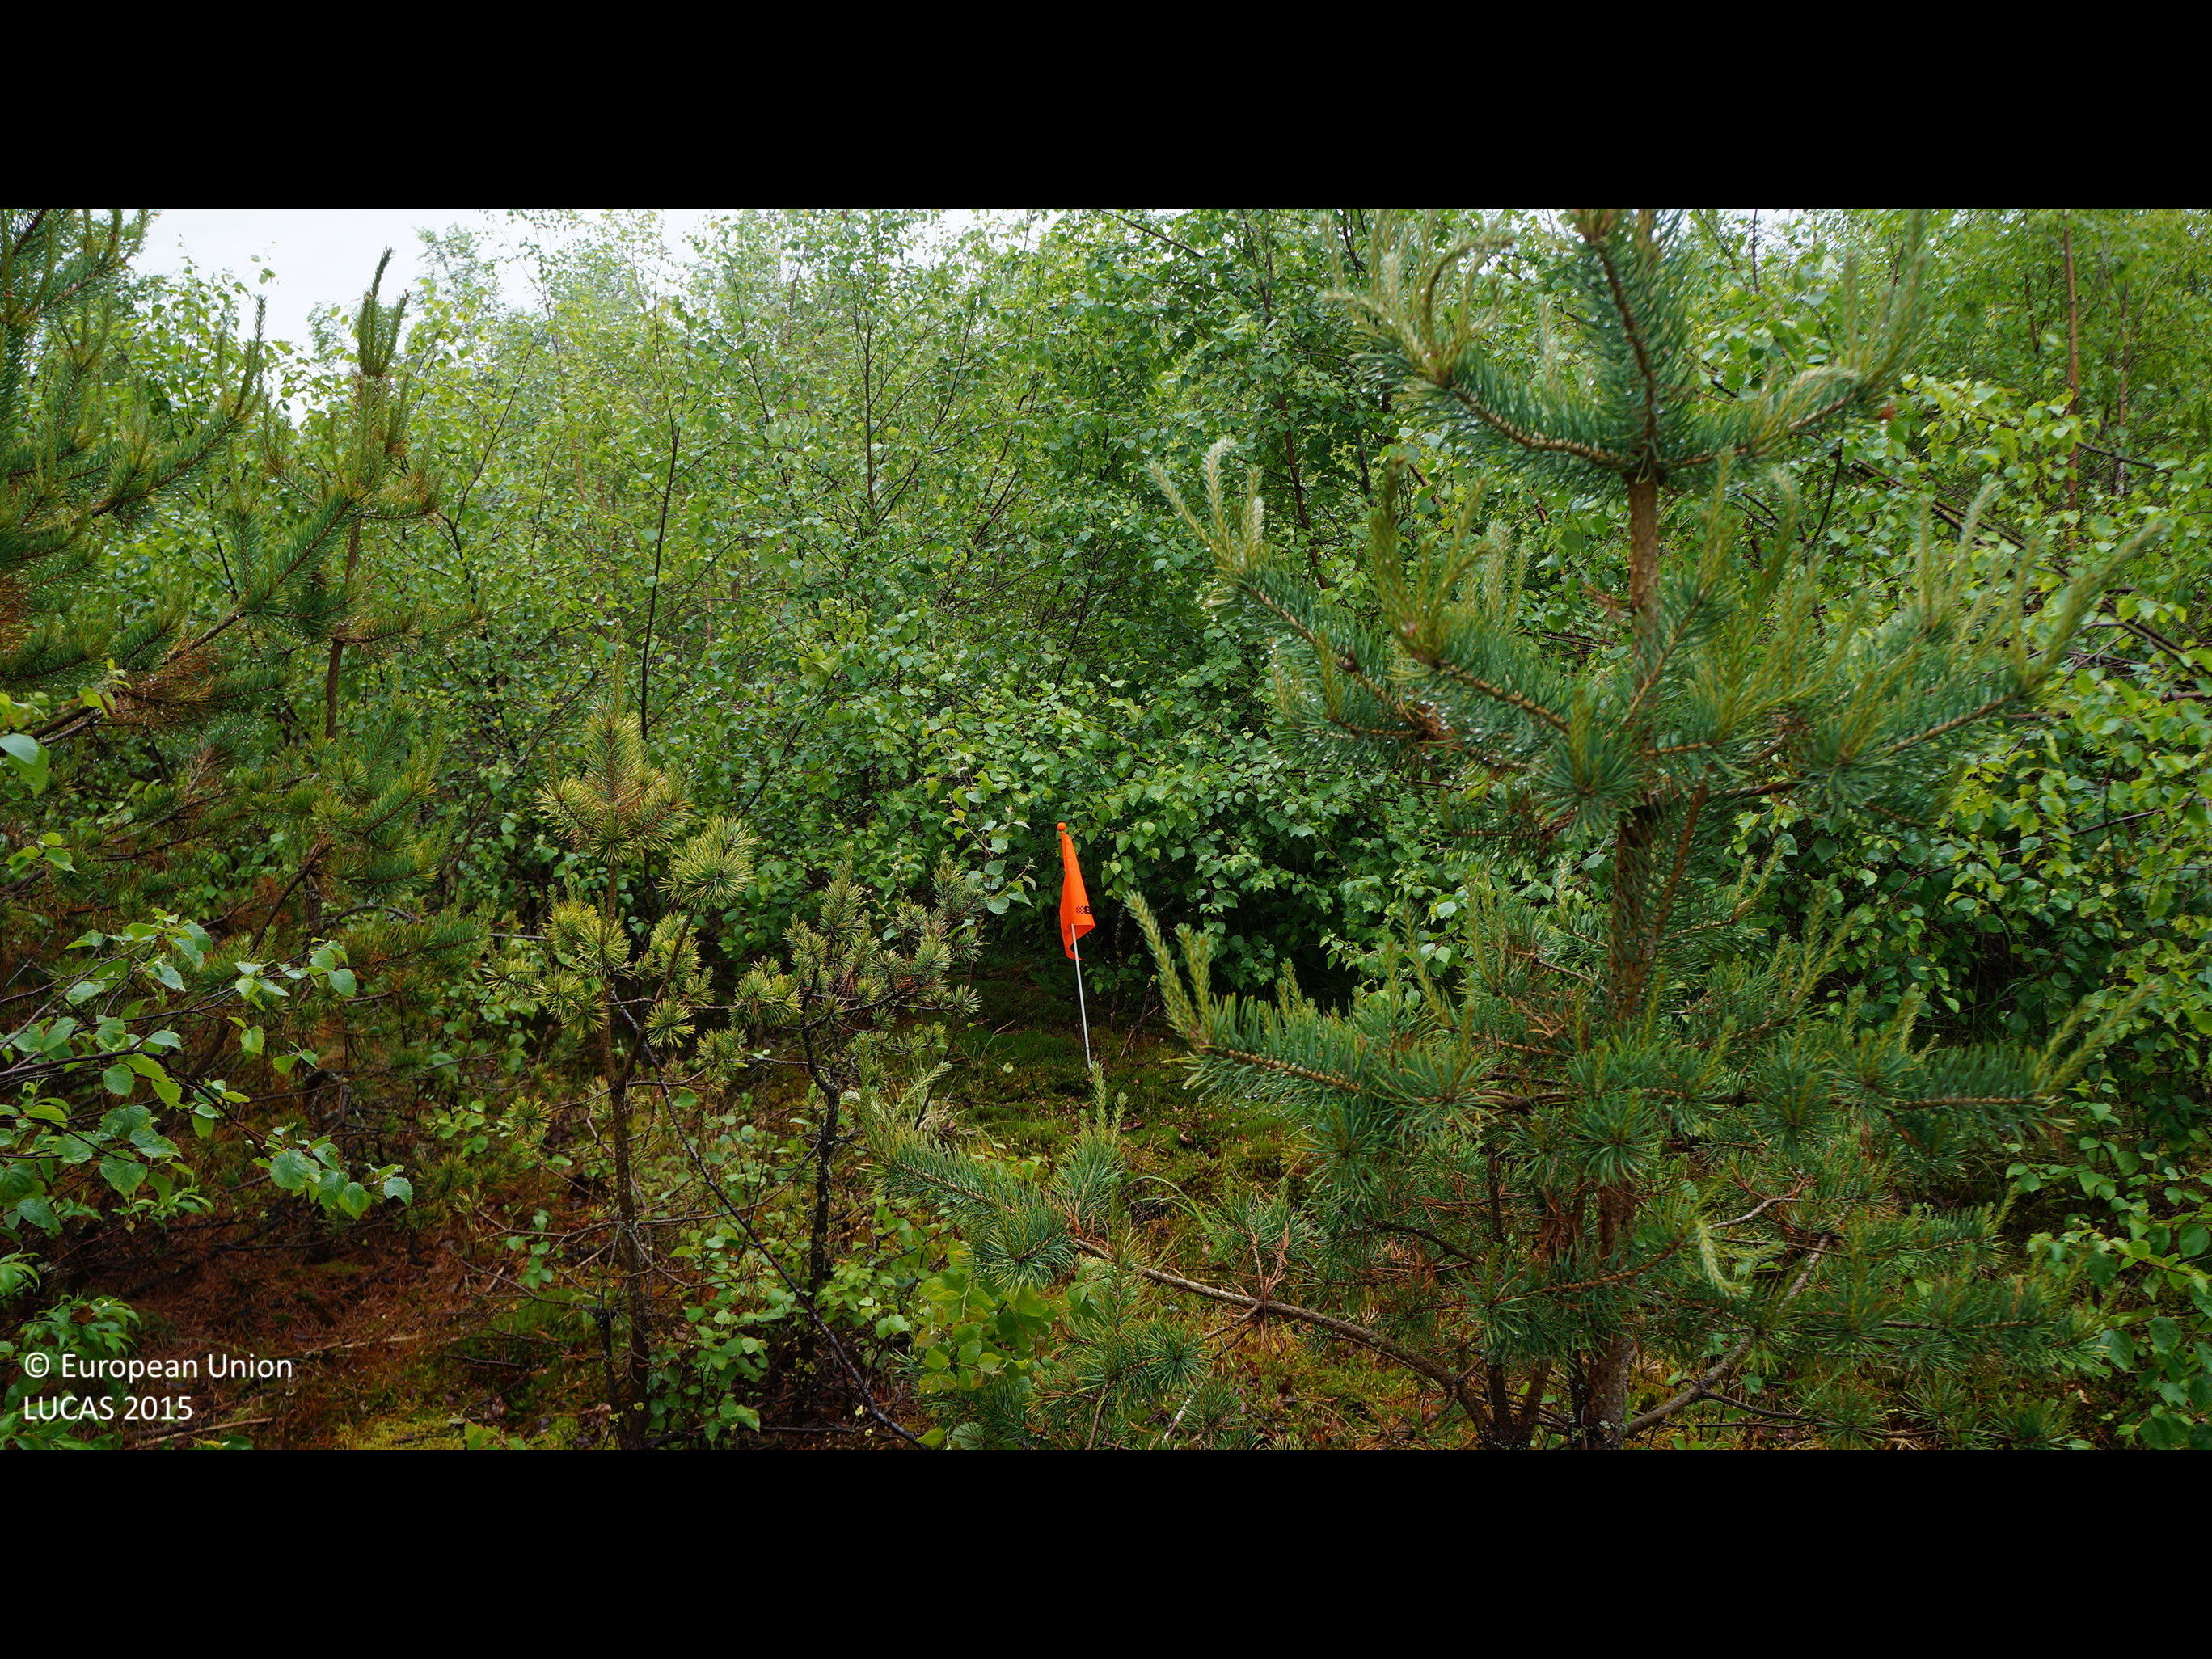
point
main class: Woodland
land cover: Broadleaved woodland
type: boreal forest
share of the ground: > 75 %
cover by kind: broadleaved forest trees 70 %, shrubs 15 %, coniferous forest trees 10 %, lichens and mosses 5 %
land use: Forestry
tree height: > 5 m
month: June
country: FI
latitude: 64.3110
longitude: 24.5663
